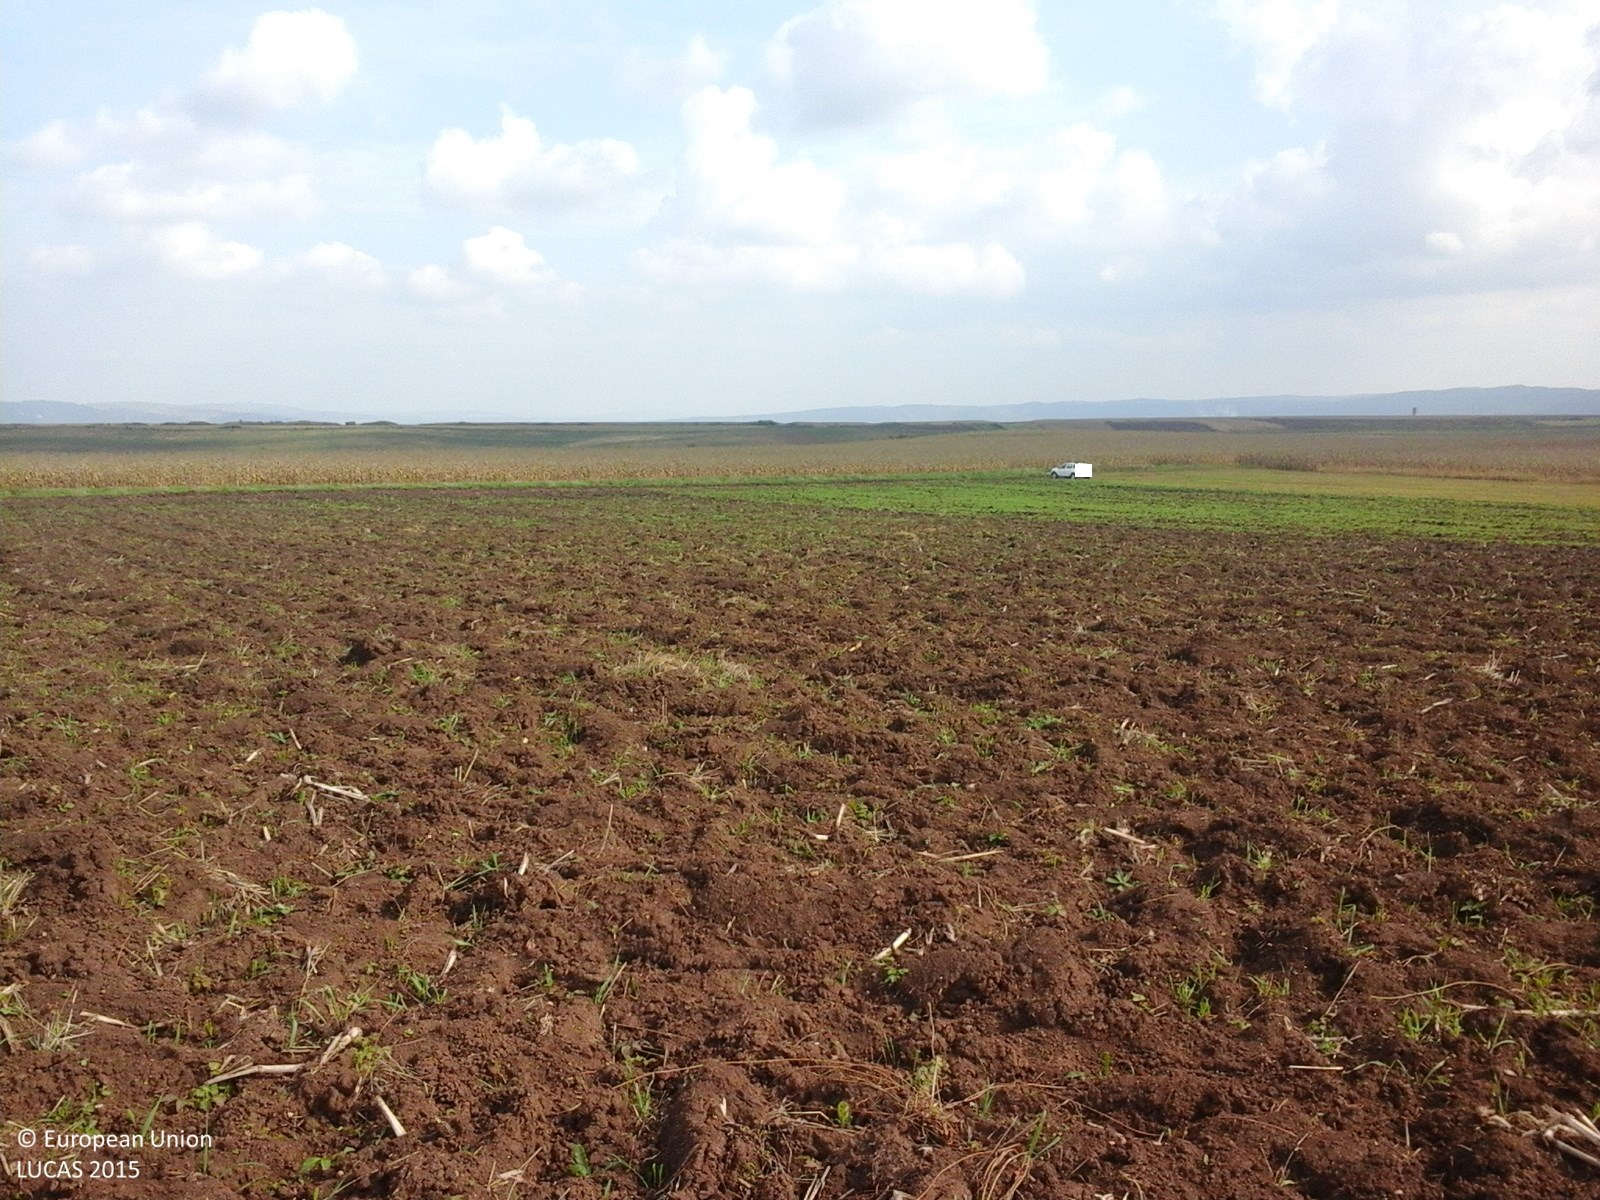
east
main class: Cropland
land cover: Maize
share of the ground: < 10 %
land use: Agriculture (excluding fallow land and kitchen gardens)
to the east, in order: Maize; Grassland without tree/shrub cover; Maize
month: October
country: RO
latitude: 46.4447
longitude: 23.8855
